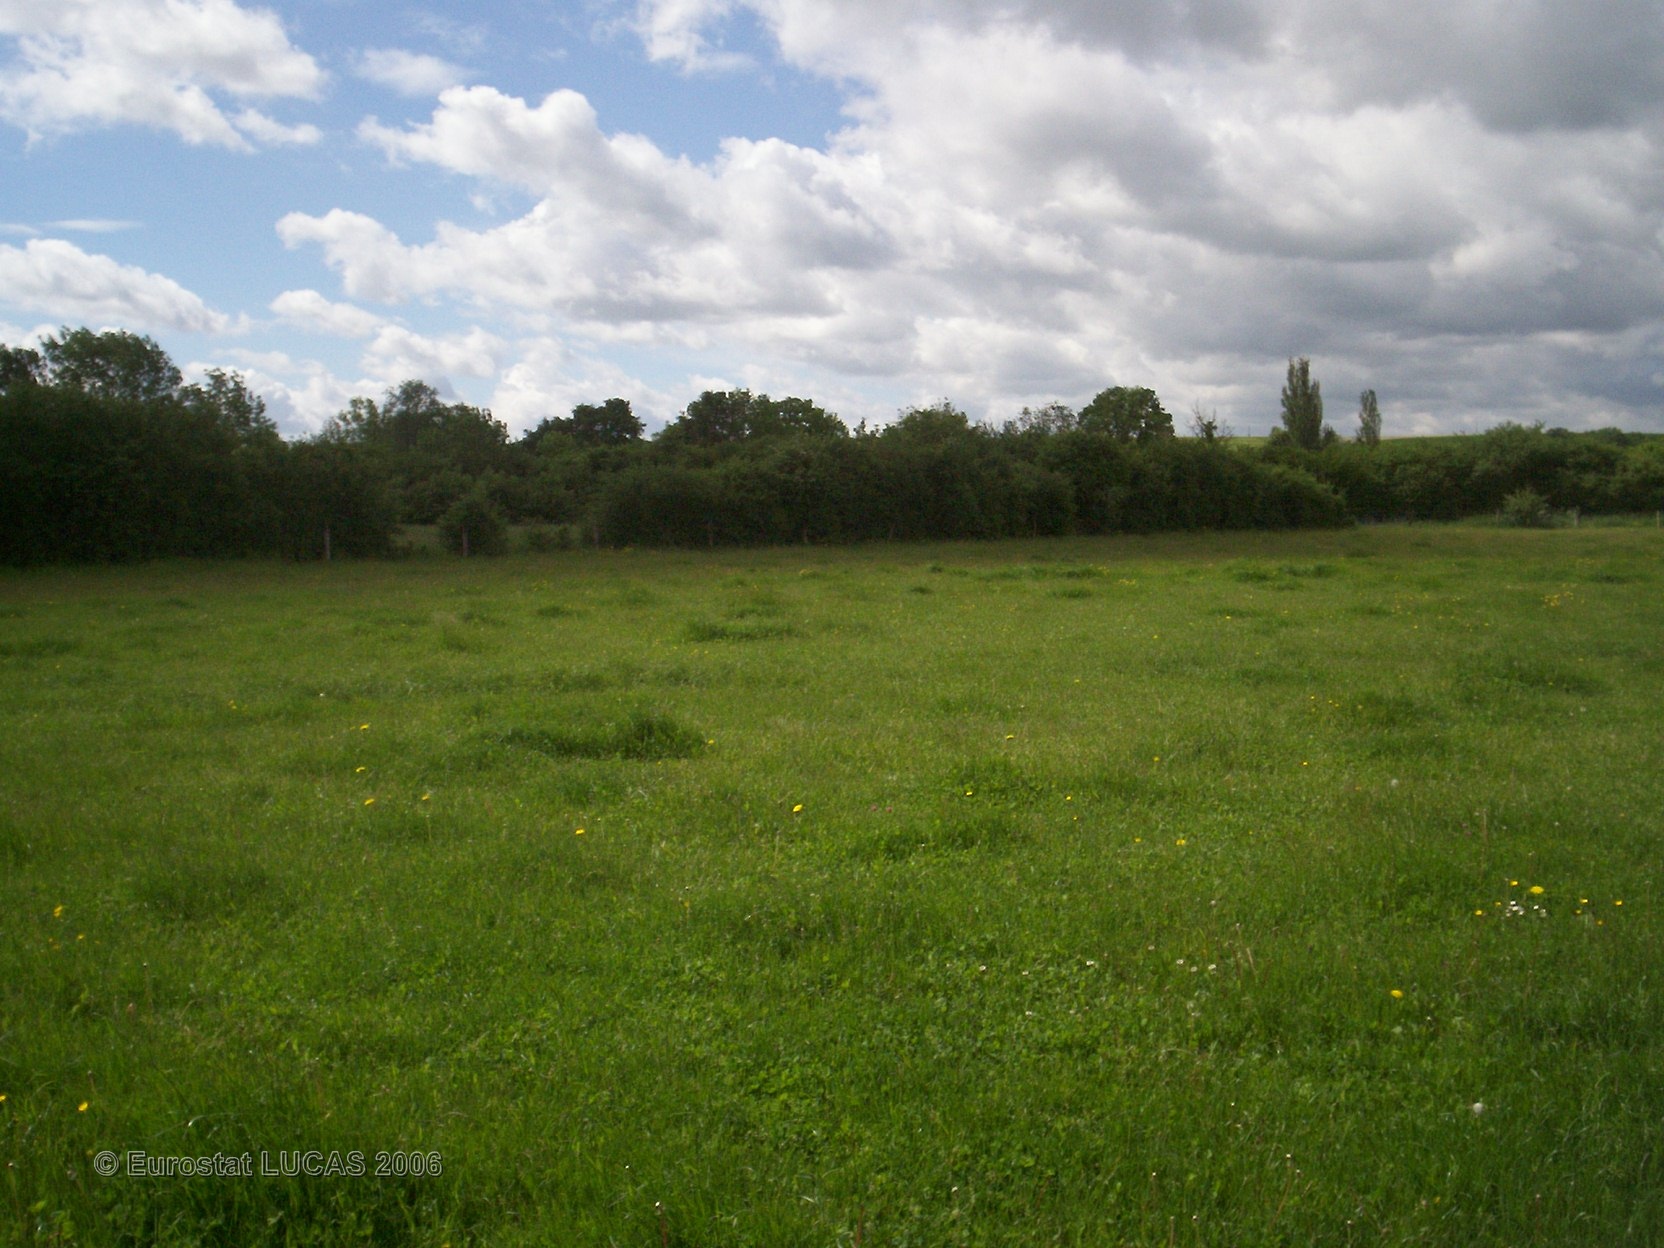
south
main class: Grassland
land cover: Grassland without tree/shrub cover
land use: Agriculture (excluding fallow land and kitchen gardens)
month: May
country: FR
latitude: 49.4894
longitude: 4.4327
